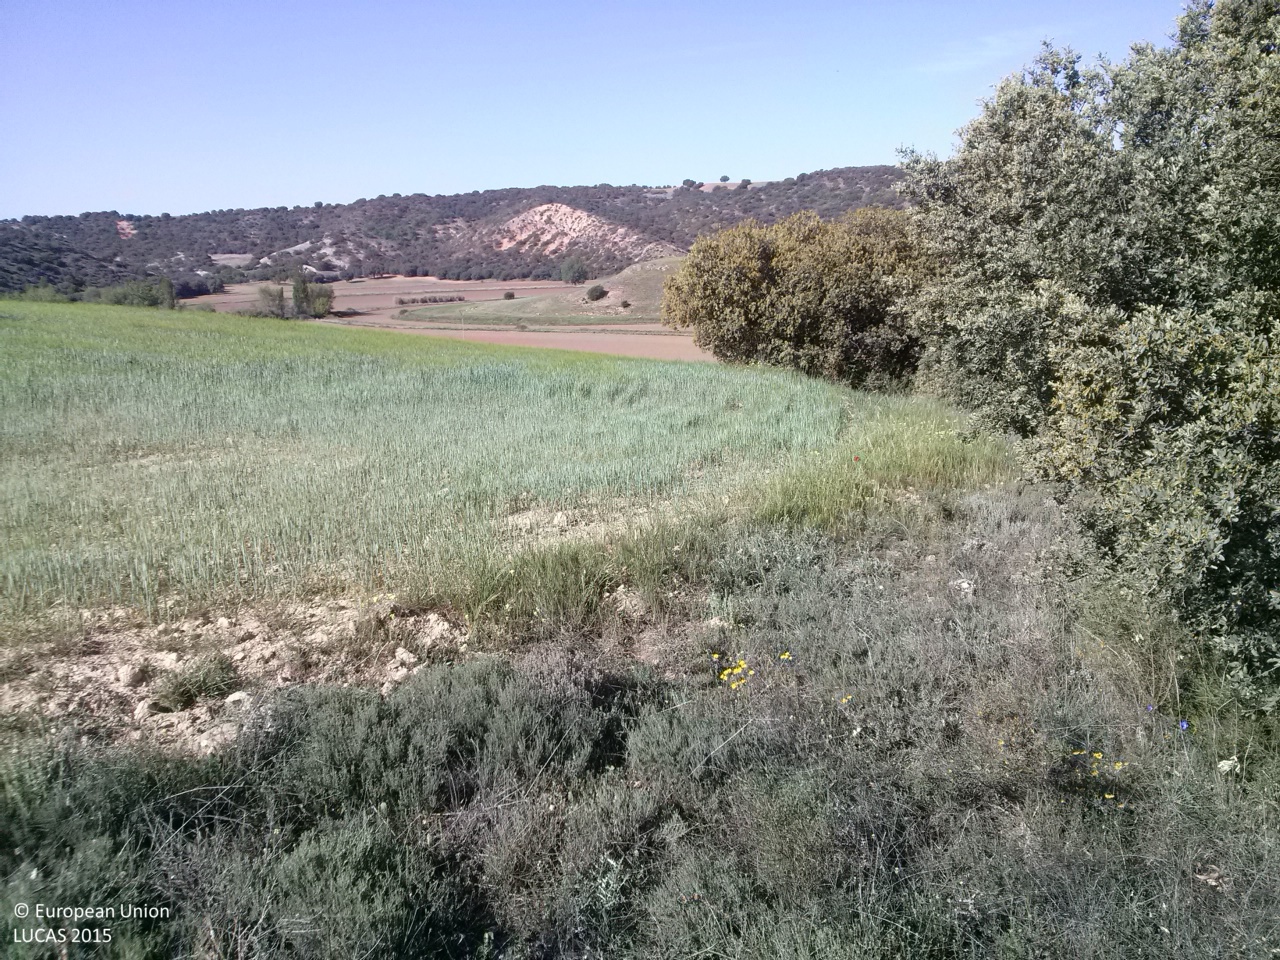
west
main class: Woodland
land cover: Broadleaved woodland
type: broadleaved evergreen forest
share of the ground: 10 - 25 %
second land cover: Shrubland without tree cover
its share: 50 - 75 %
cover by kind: shrubs 60 %, herbaceous plants 25 %, broadleaved forest trees 15 %
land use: Forestry
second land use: Agriculture (excluding fallow land and kitchen gardens)
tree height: < 5 m
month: May
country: ES
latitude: 39.8824
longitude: -2.8007
